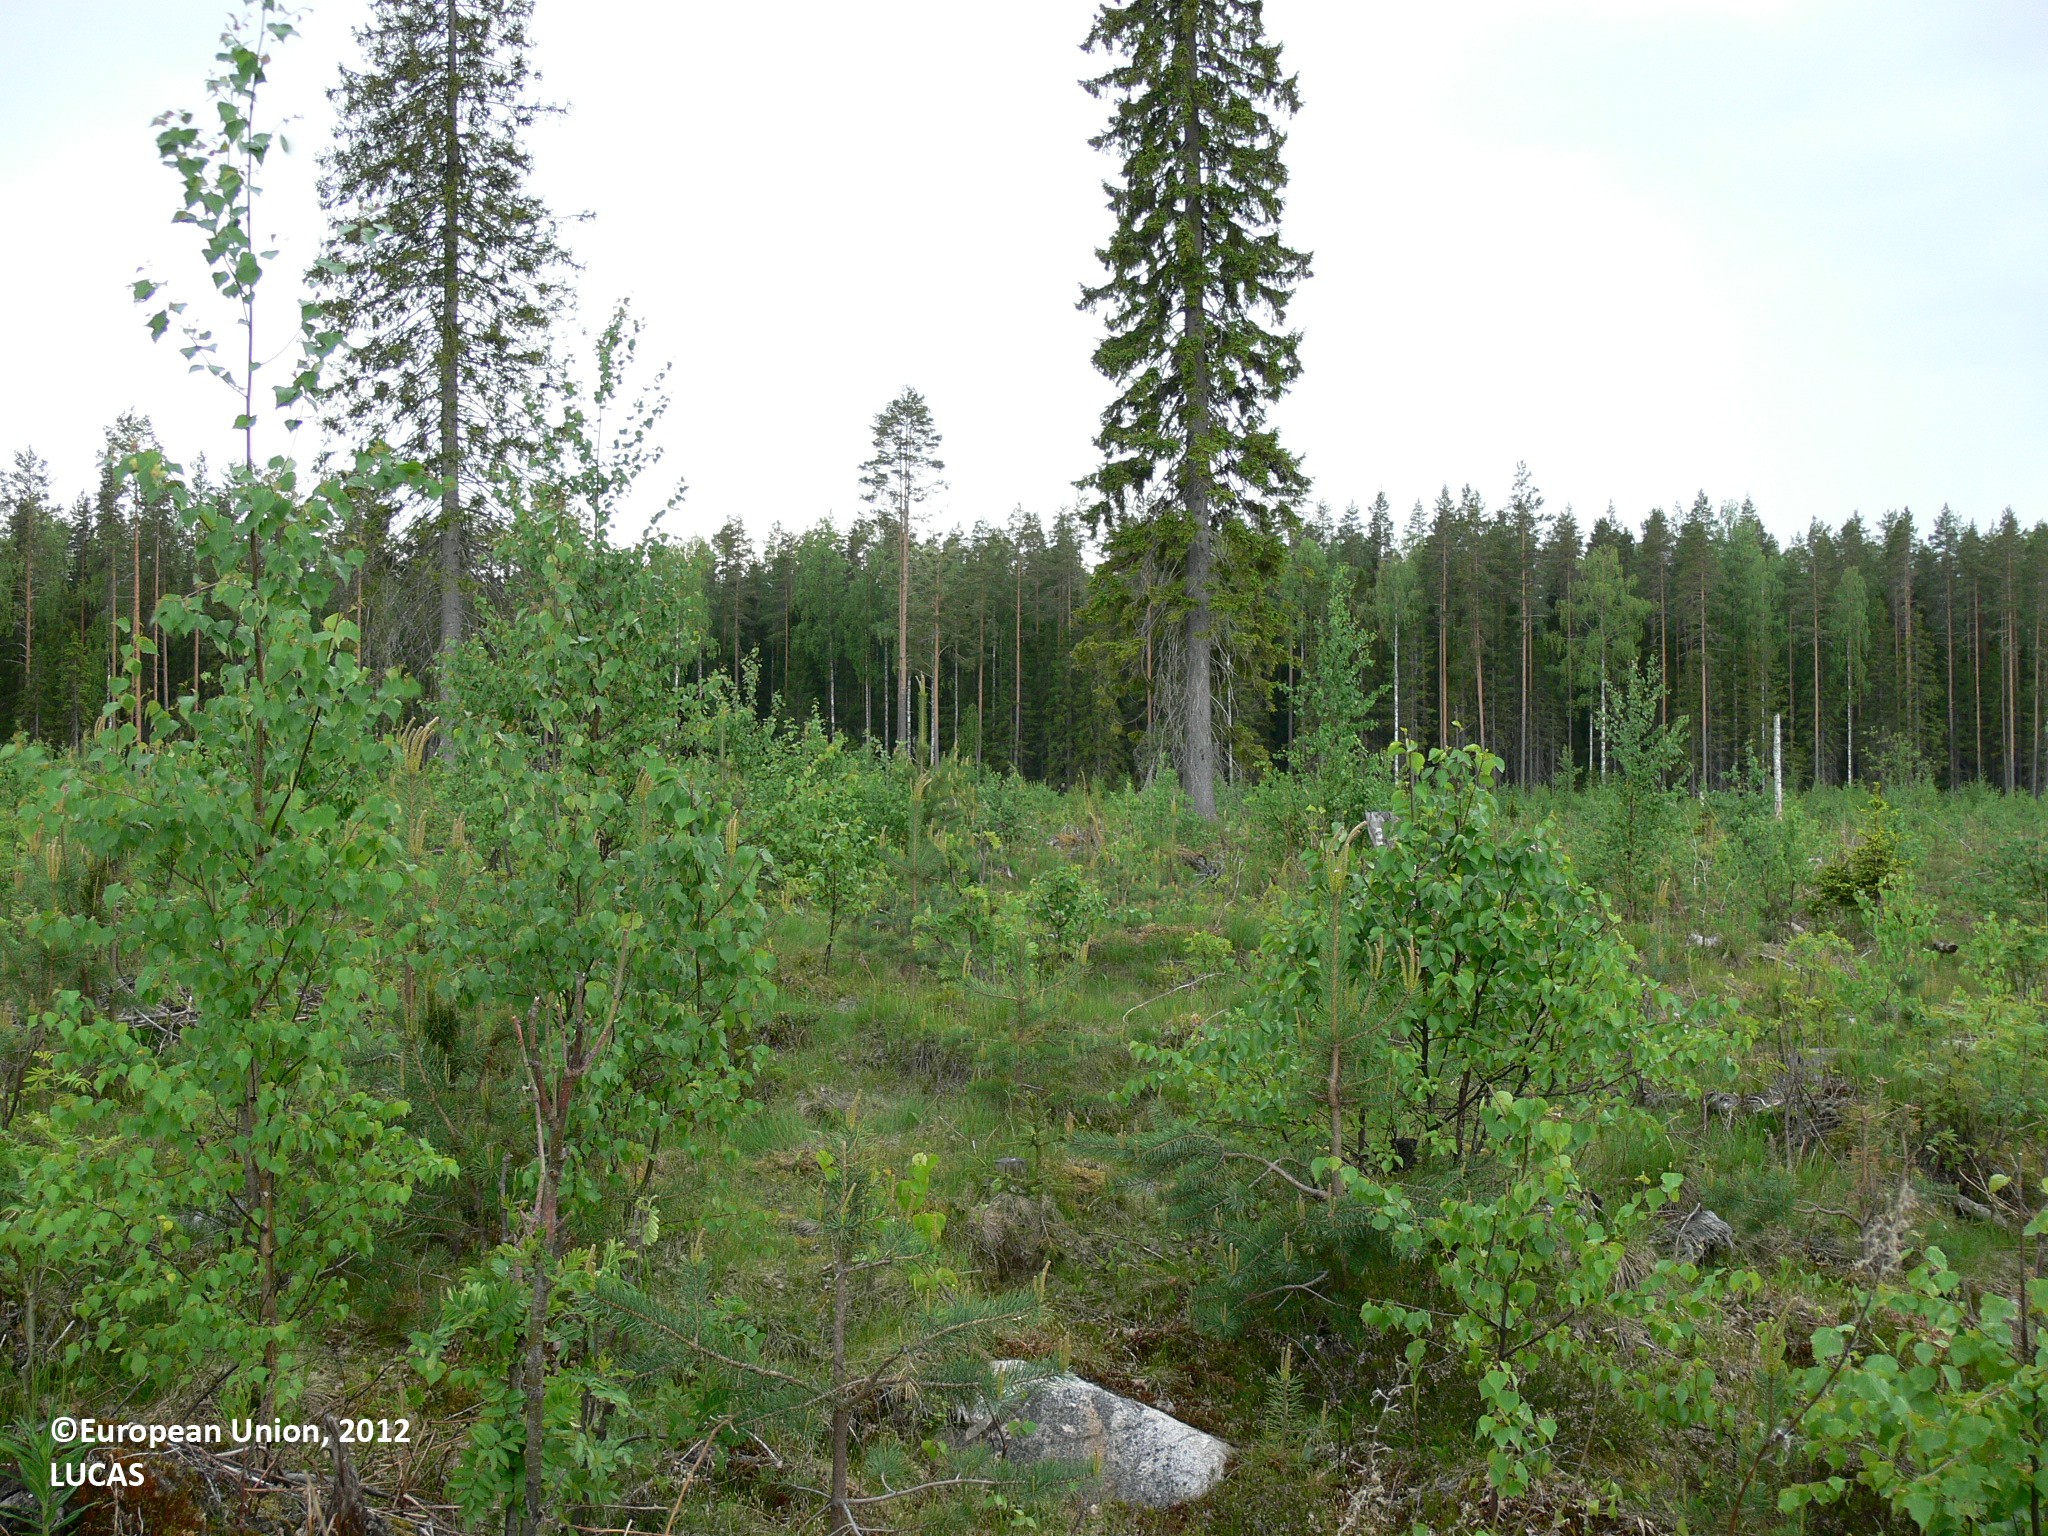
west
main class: Woodland
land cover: Other mixed woodland
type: boreal forest
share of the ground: 25 - 50 %
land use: Forestry
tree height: < 5 m
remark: Clear cut
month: June
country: FI
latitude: 62.6415
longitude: 30.3444
